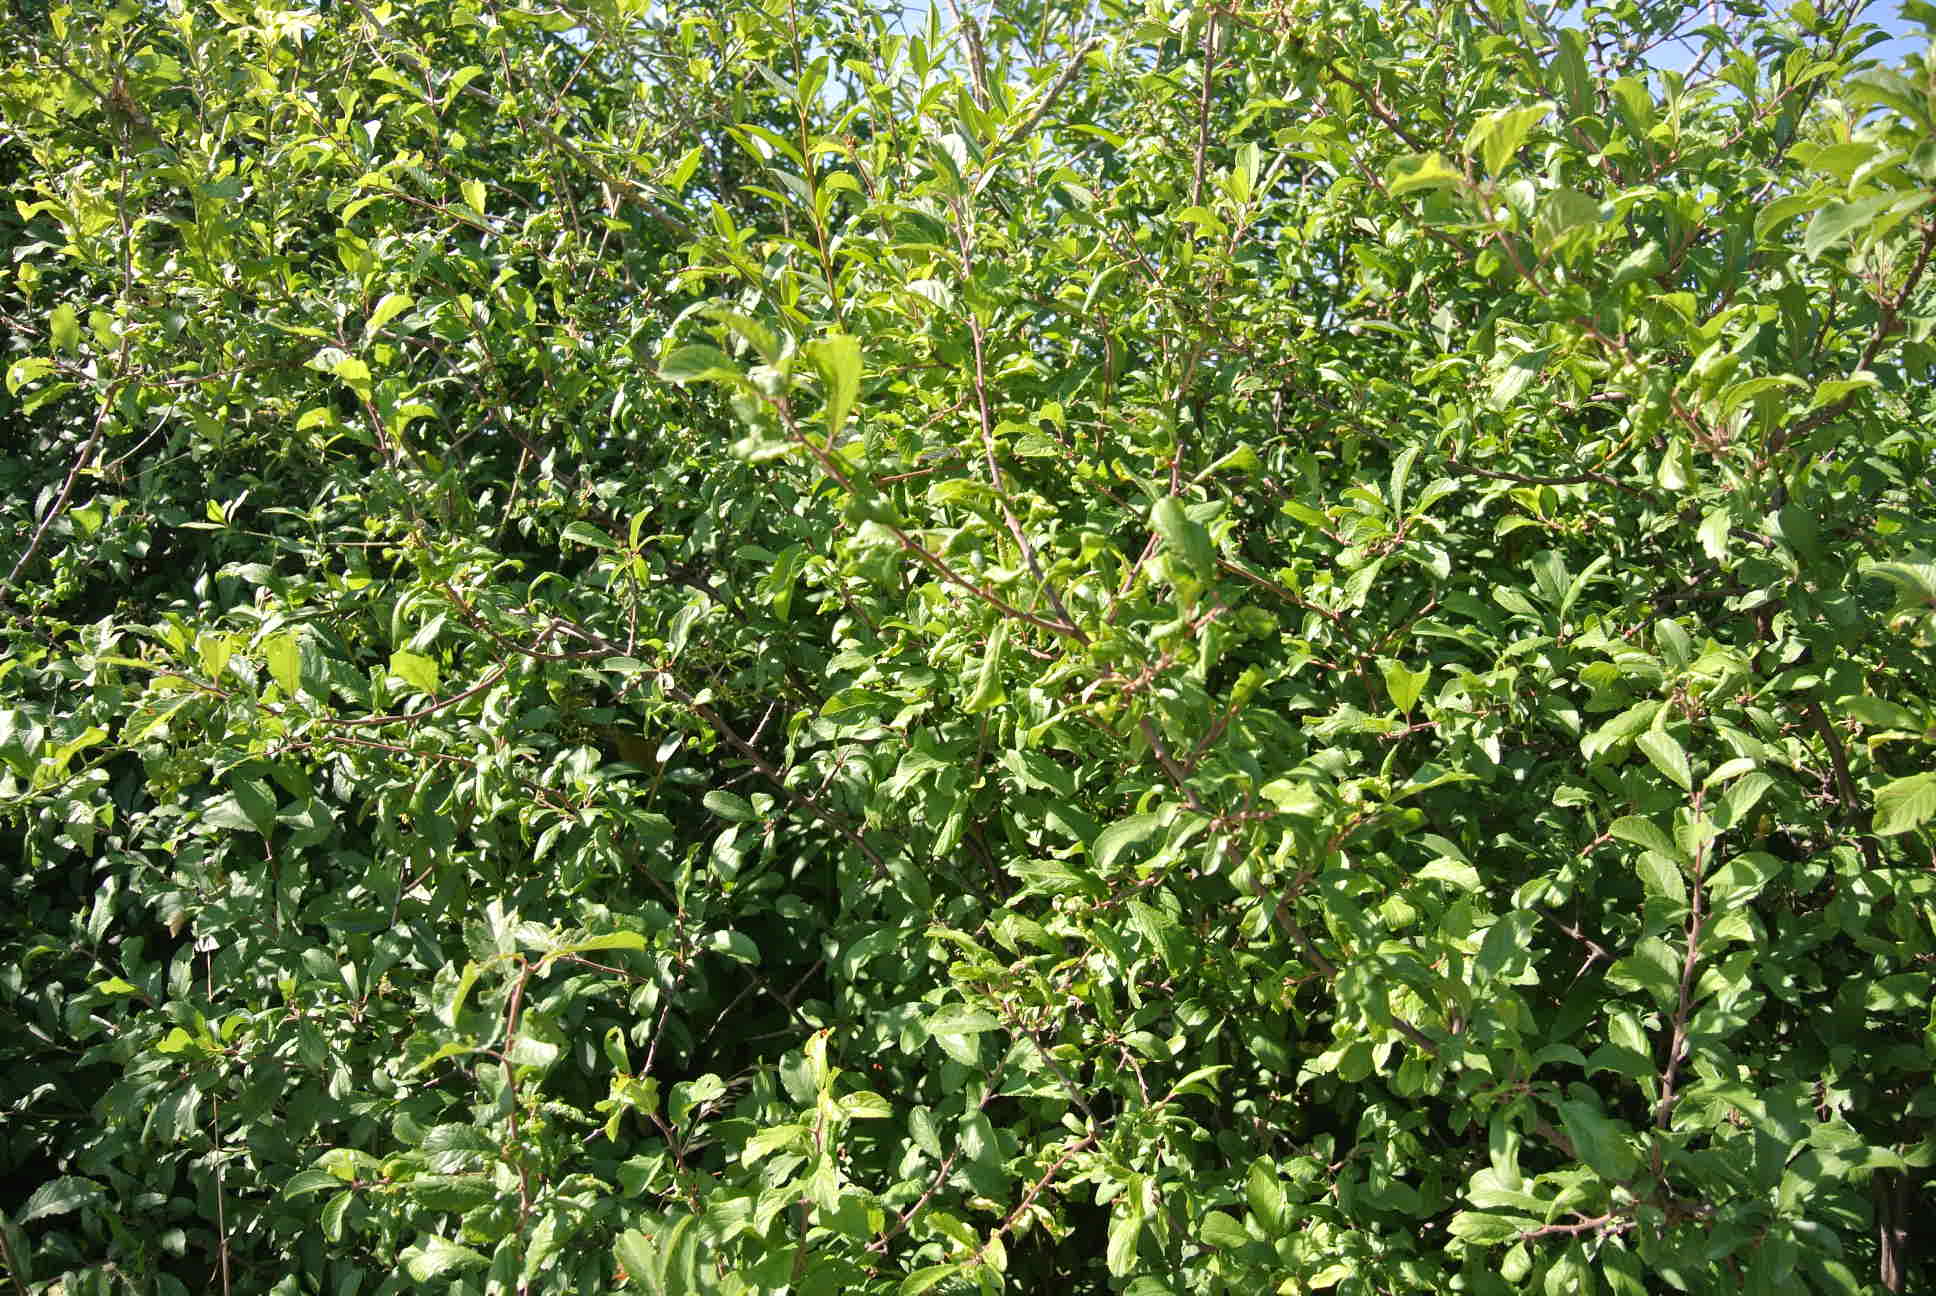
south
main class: Cropland
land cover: Durum wheat
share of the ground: > 75 %
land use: Agriculture (excluding fallow land and kitchen gardens)
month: July
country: AT
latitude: 47.7658
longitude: 16.1006
